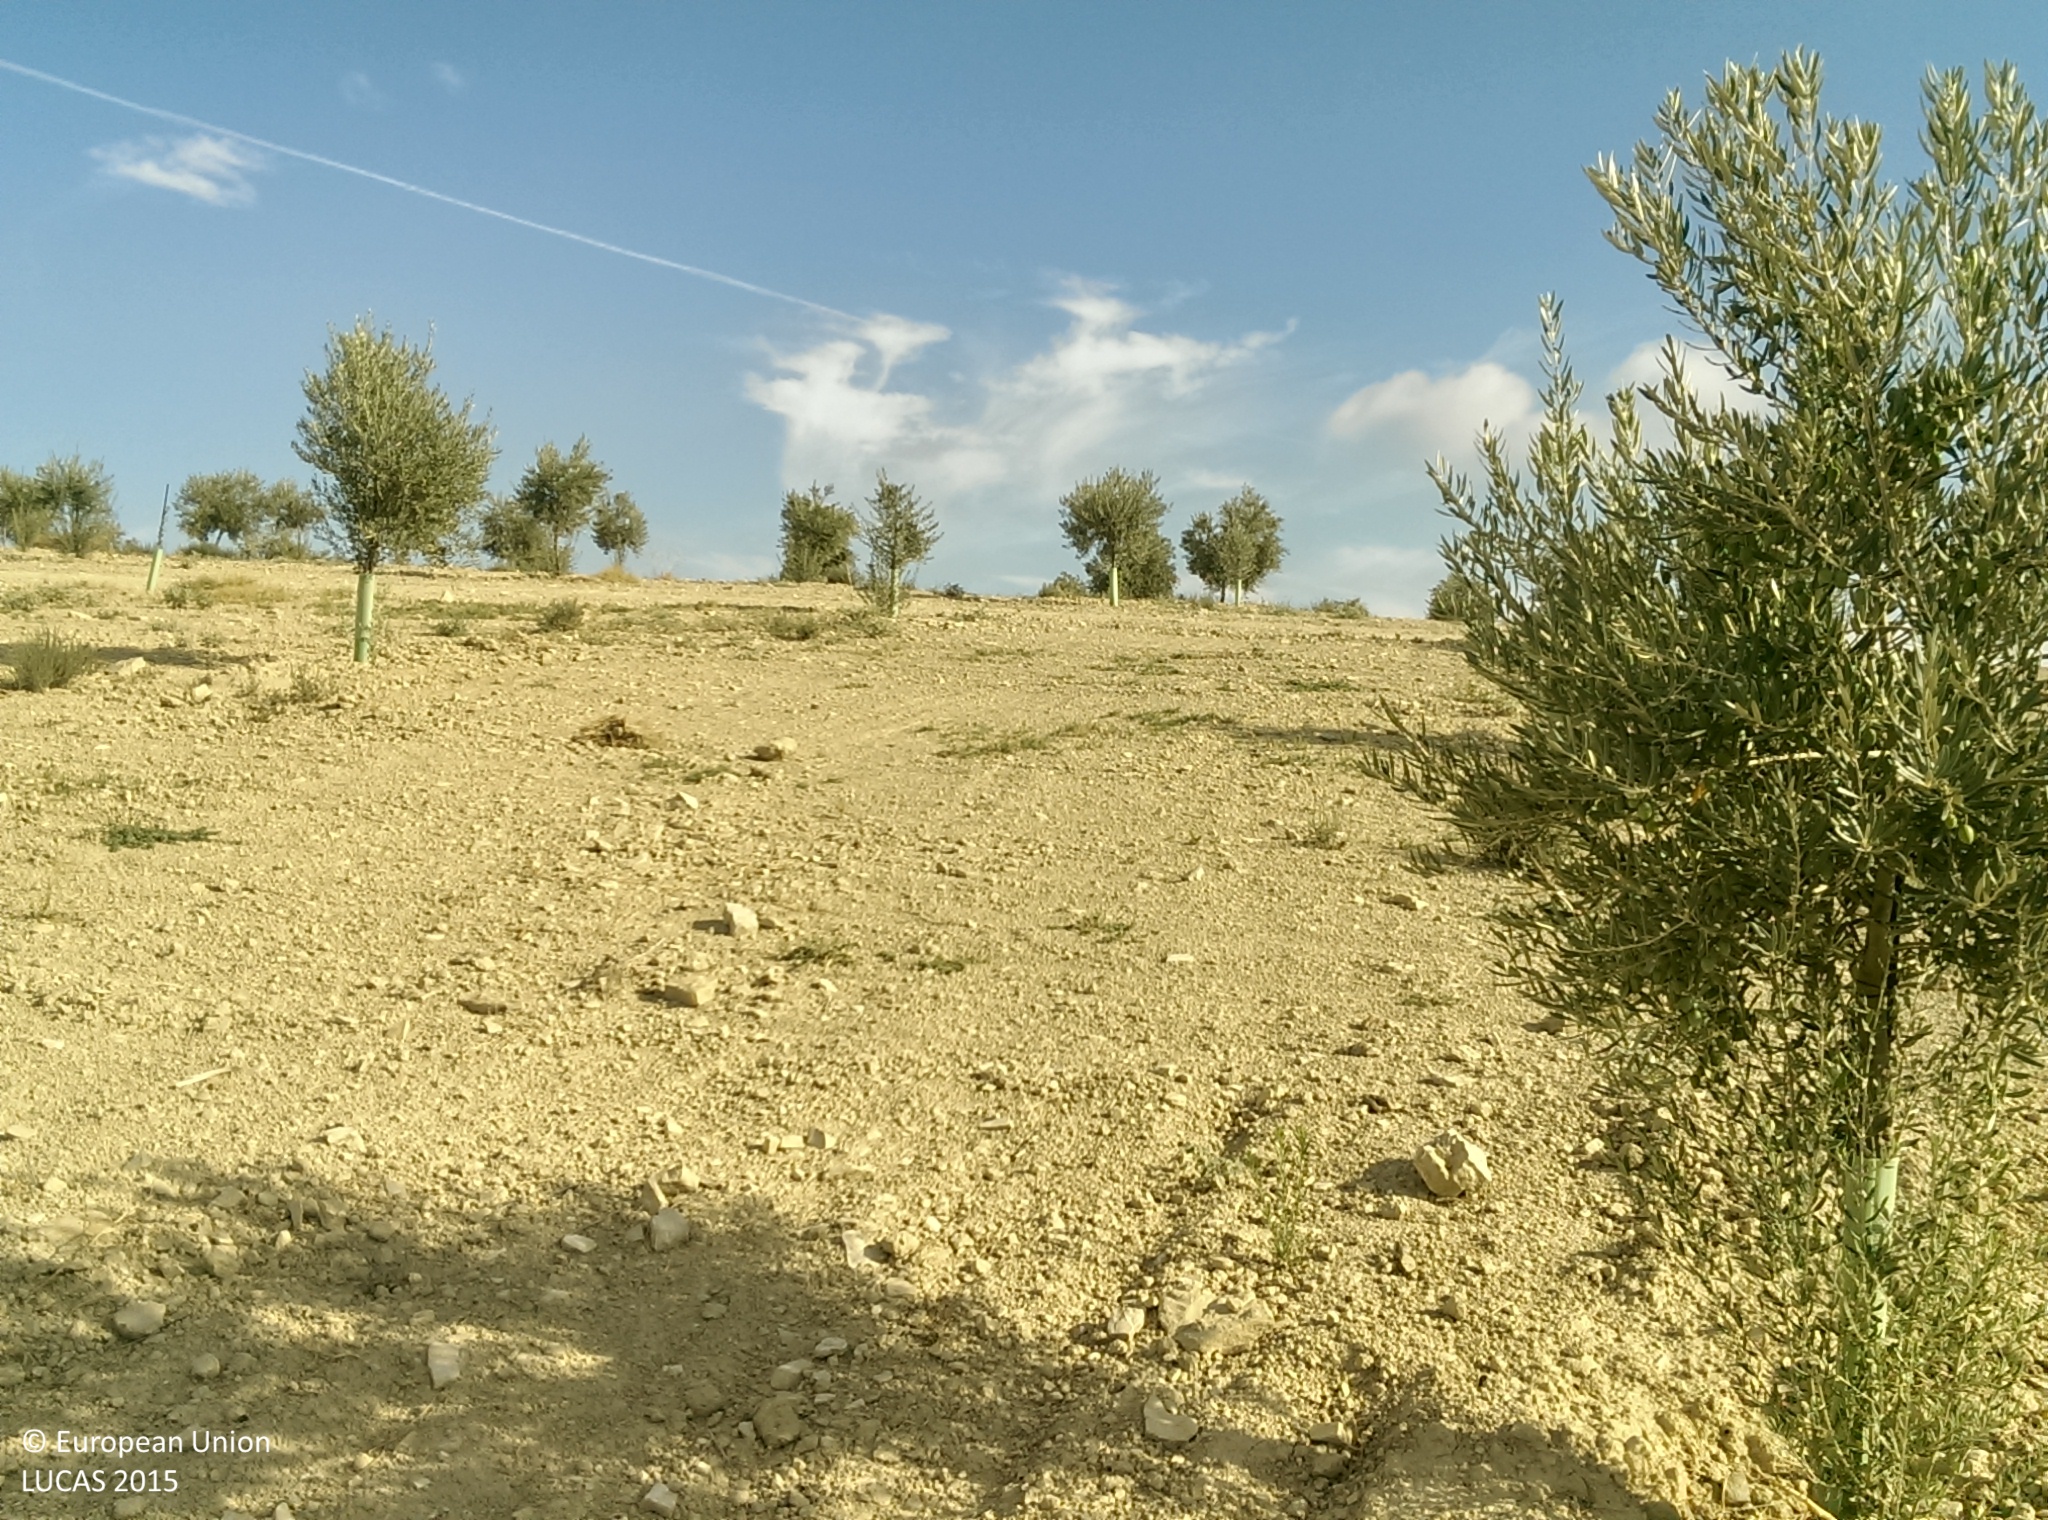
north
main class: Cropland
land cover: Olive groves
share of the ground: < 10 %
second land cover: Other bare soil
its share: > 75 %
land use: Agriculture (excluding fallow land and kitchen gardens)
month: August
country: ES
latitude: 37.1381
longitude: -3.6897
